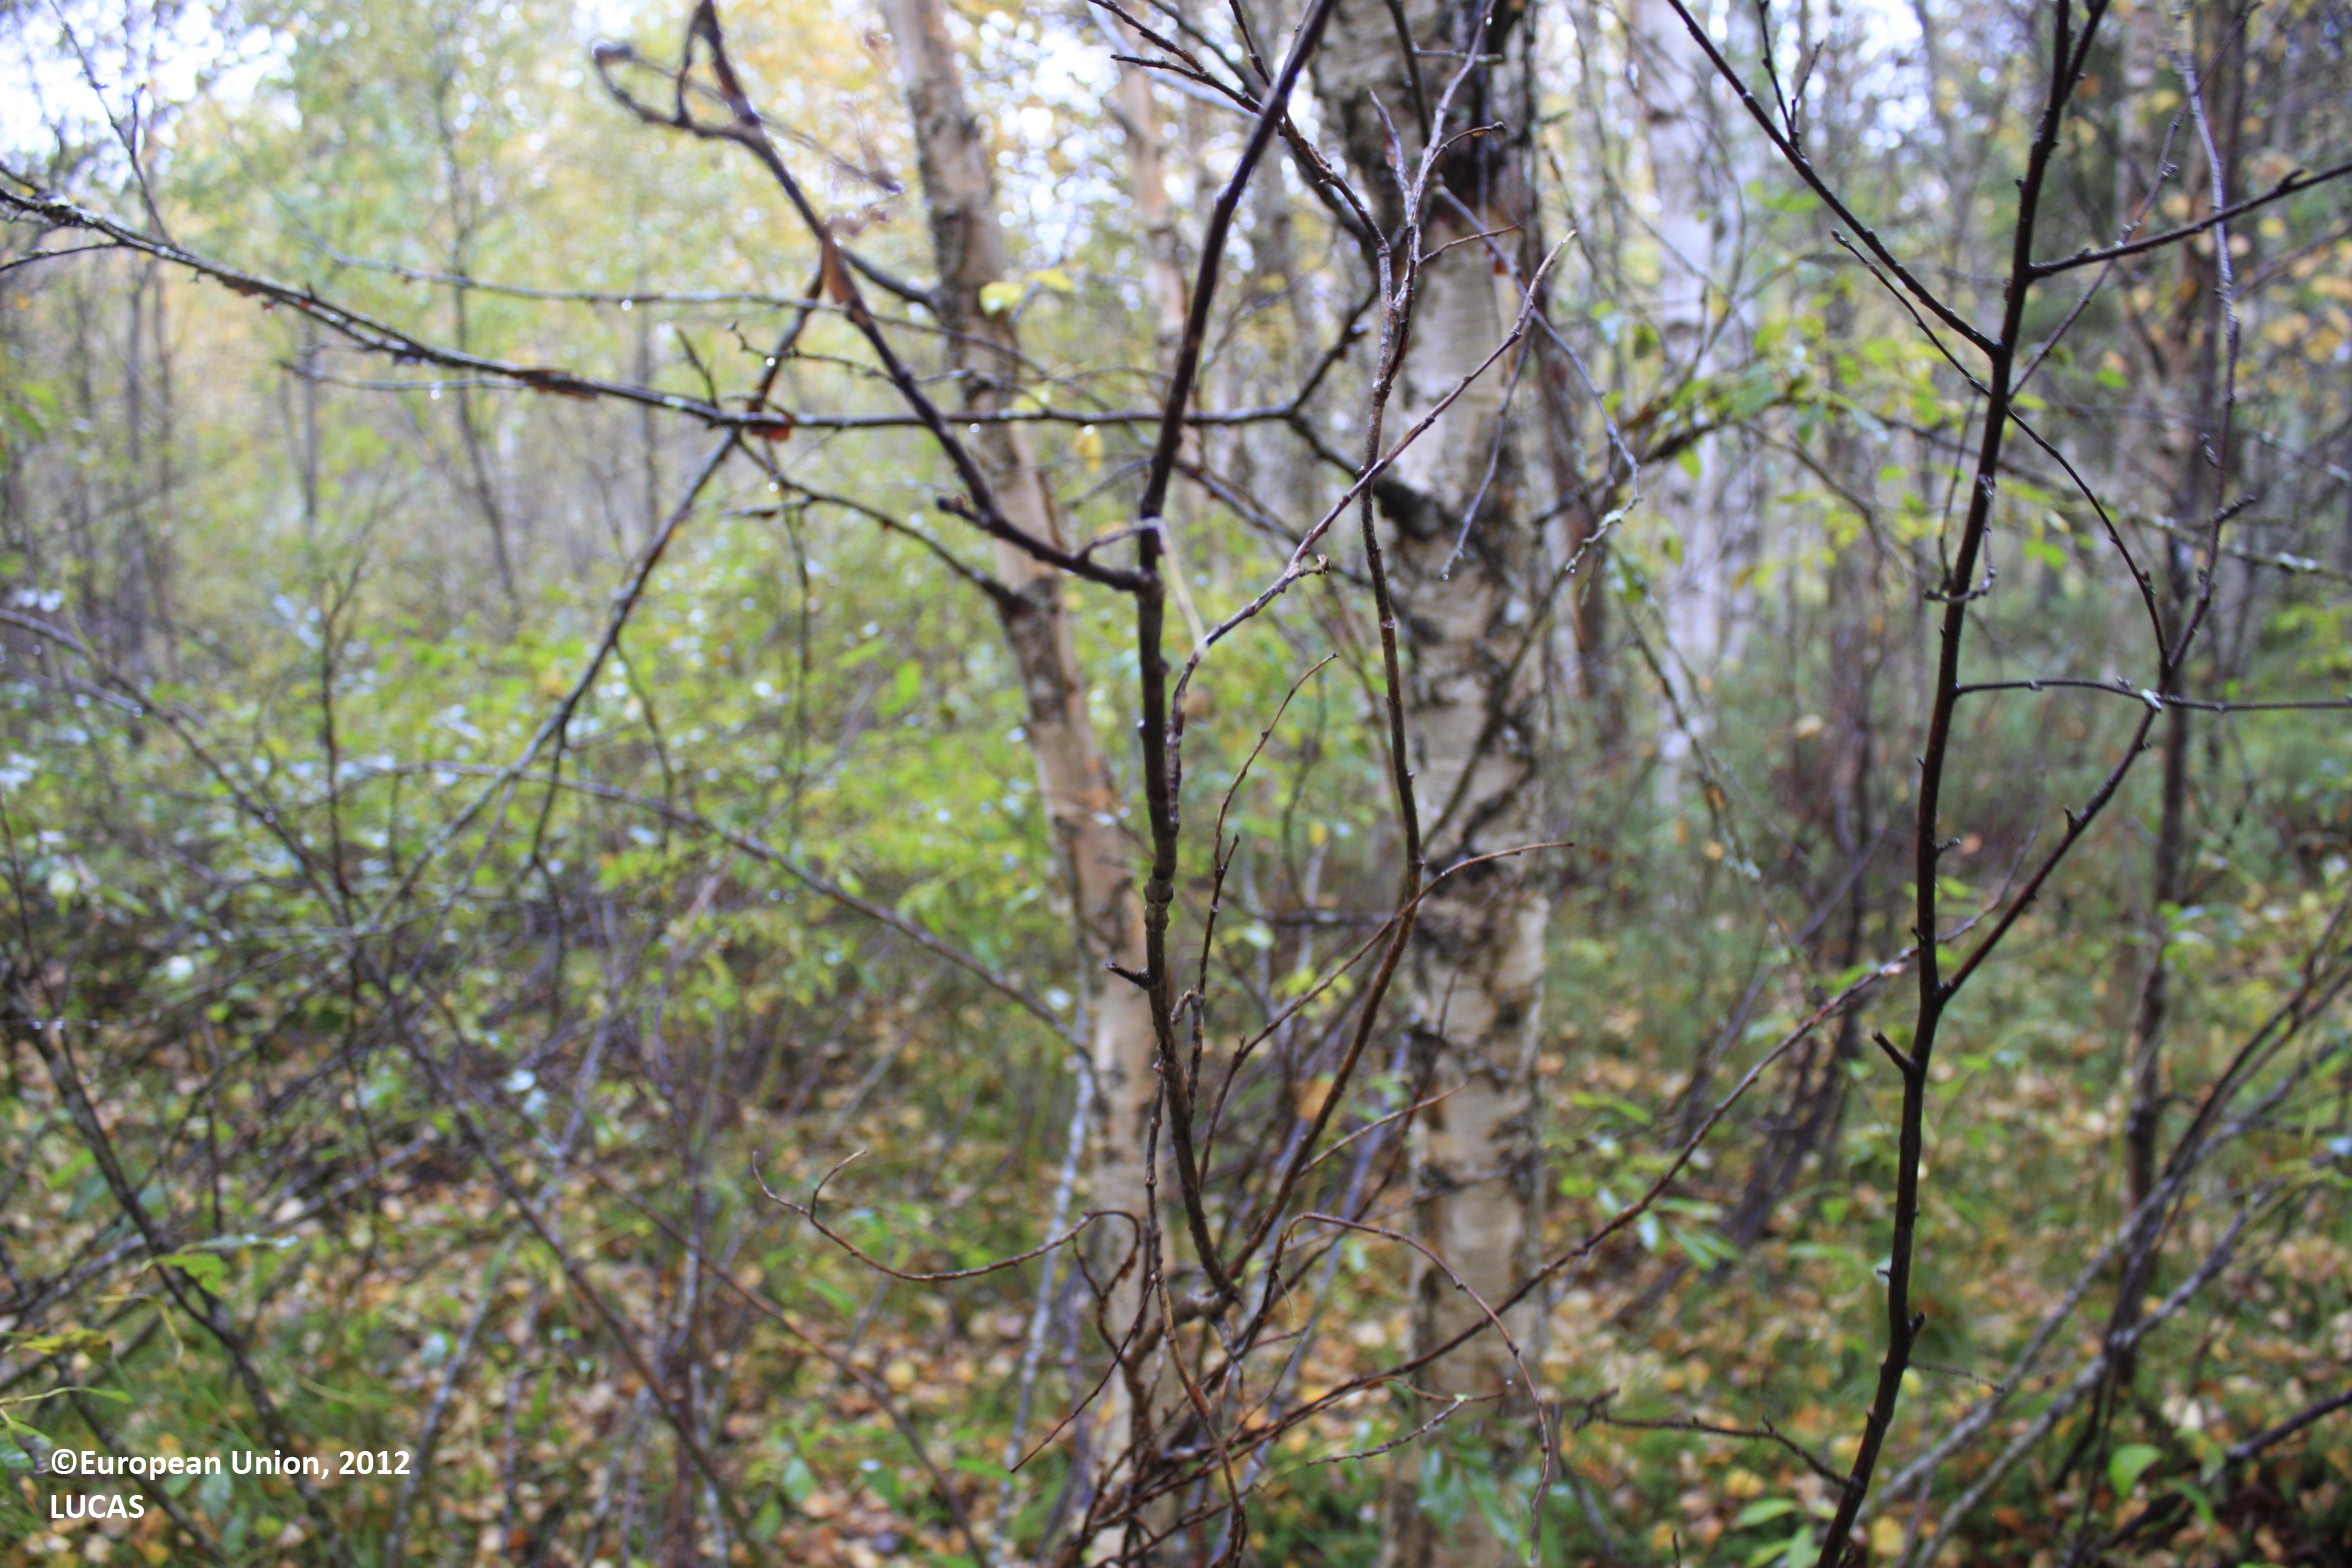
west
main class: Woodland
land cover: Broadleaved woodland
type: boreal forest
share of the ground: > 75 %
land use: Forestry
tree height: > 5 m
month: September
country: FI
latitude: 65.6406
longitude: 27.3981
